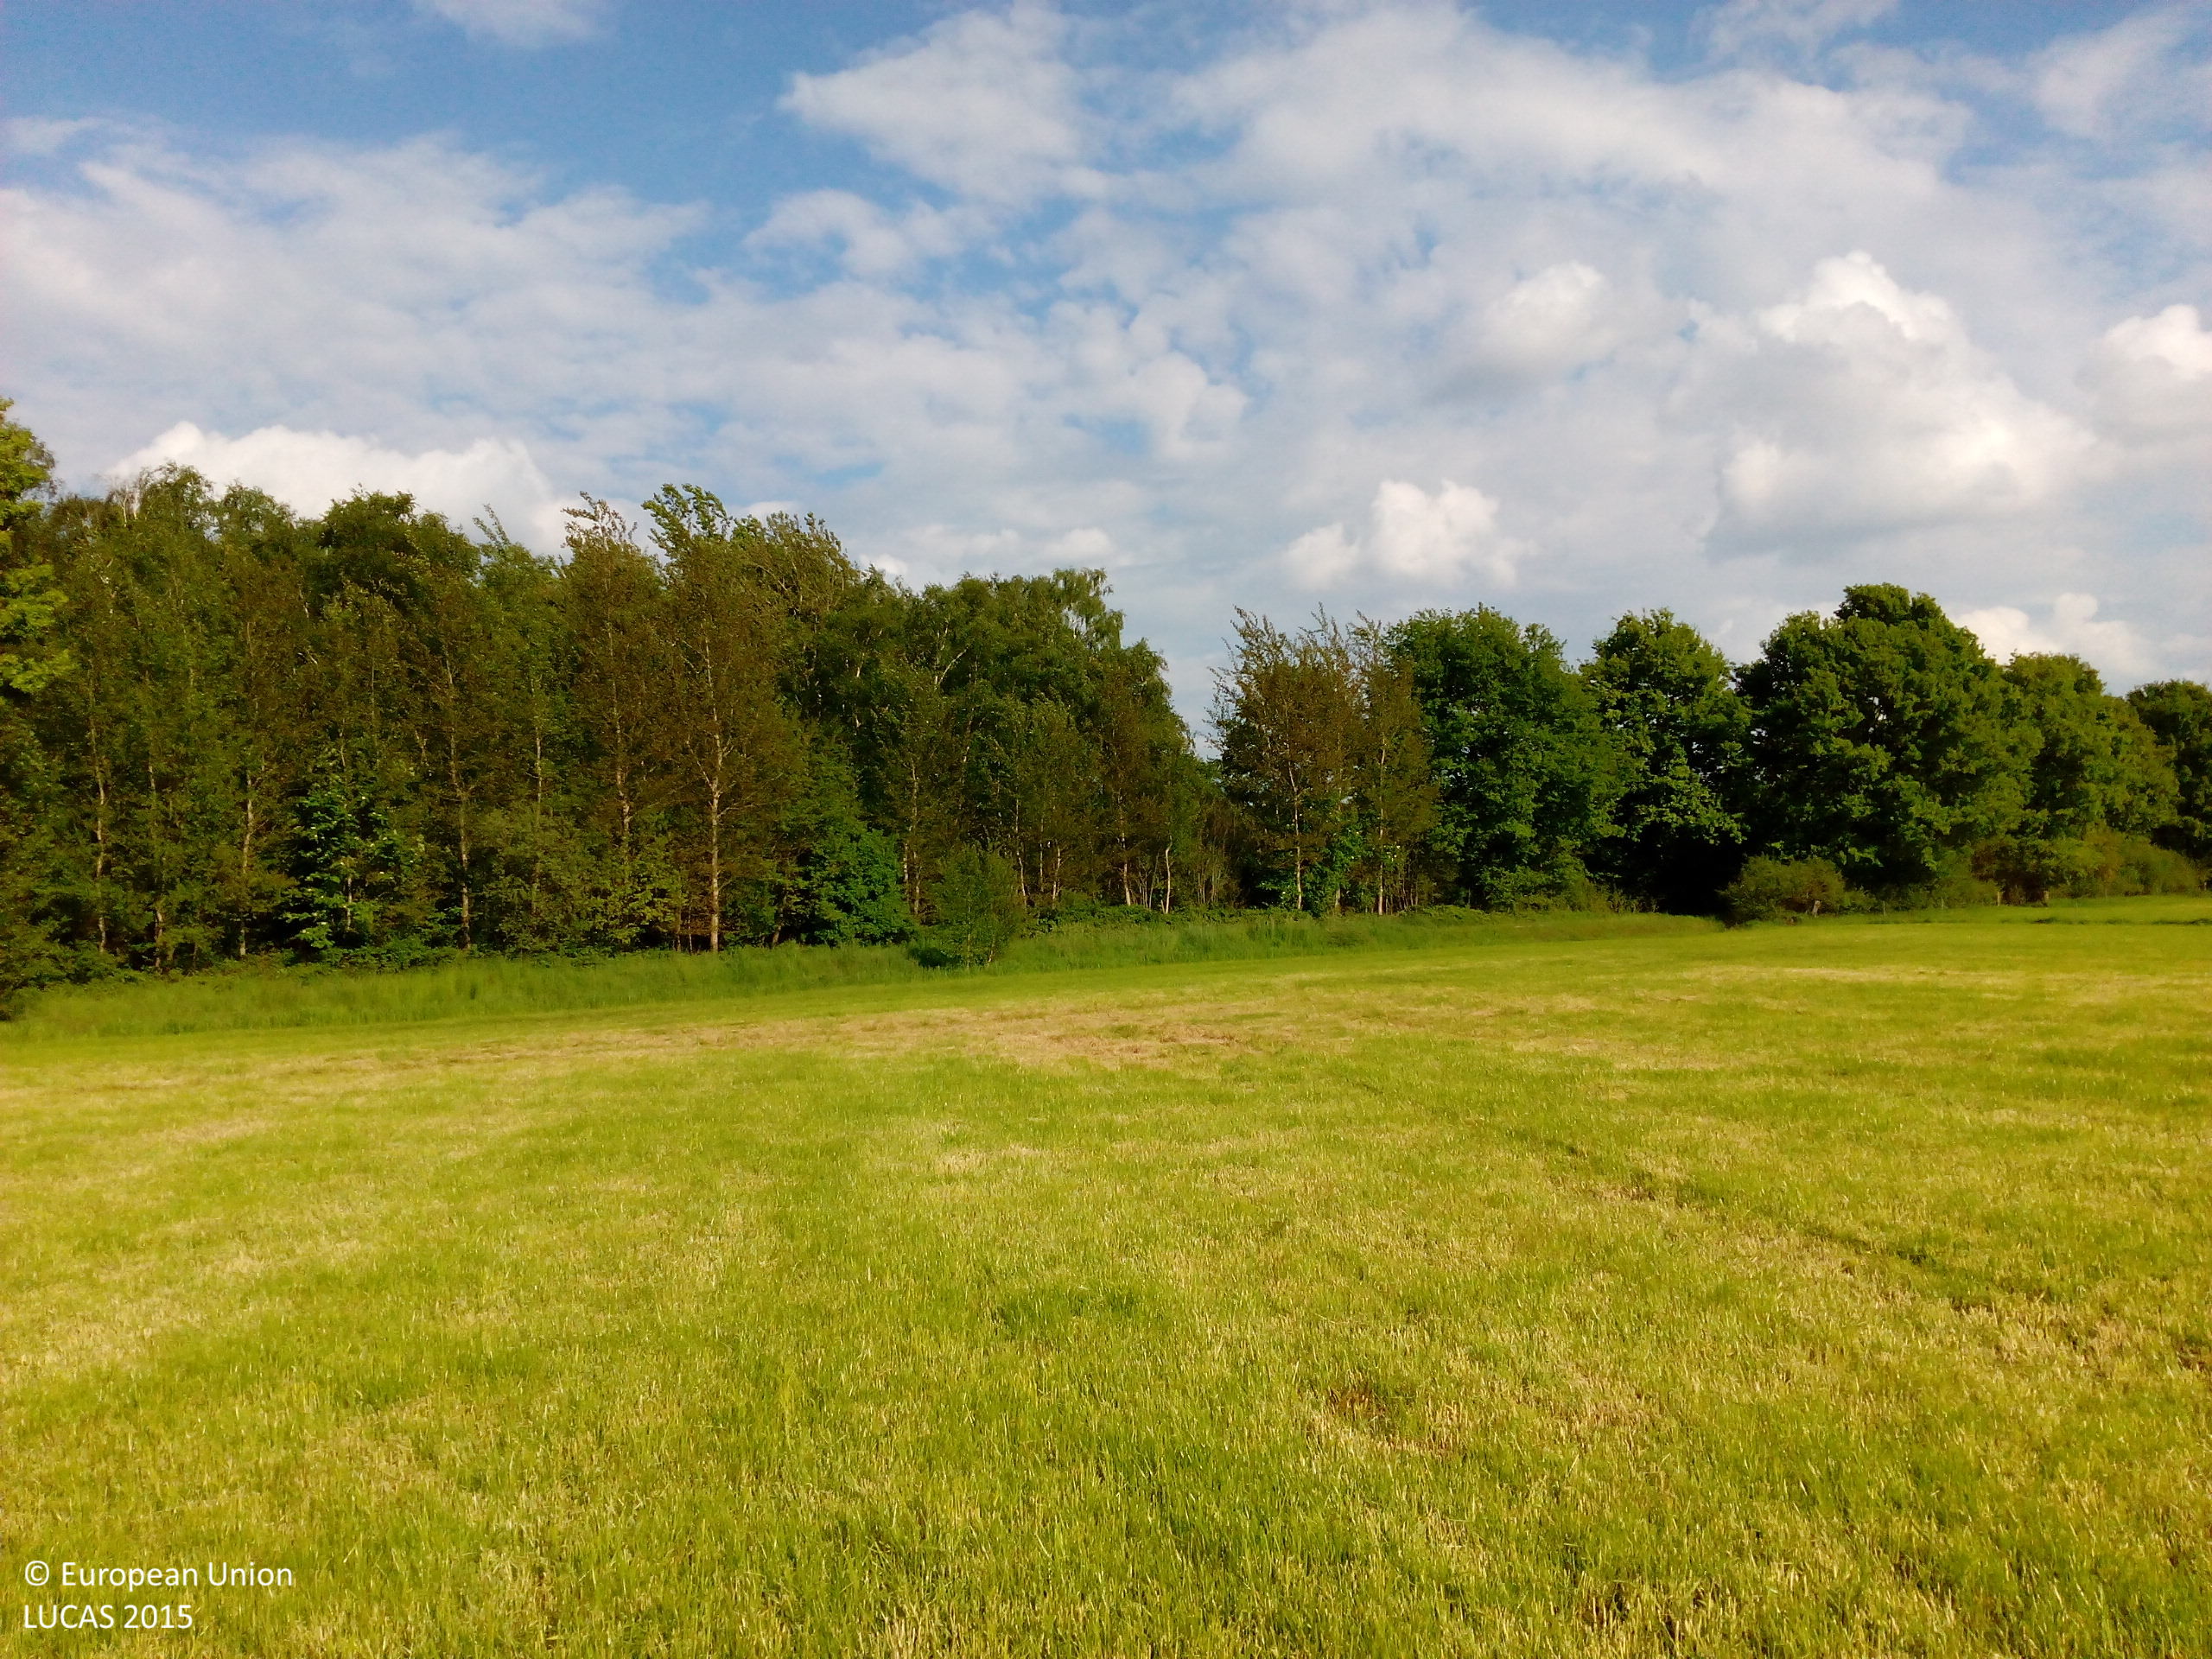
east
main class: Grassland
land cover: Grassland without tree/shrub cover
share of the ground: > 75 %
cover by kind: herbaceous plants 100 %
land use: Agriculture (excluding fallow land and kitchen gardens)
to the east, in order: Grassland without tree/shrub cover; Grass margins; Ditches and canals; Grass margins; Tracks; Broadleaved woodland; Grassland without tree/shrub cover
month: May
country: DE
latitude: 52.1881
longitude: 7.4405
